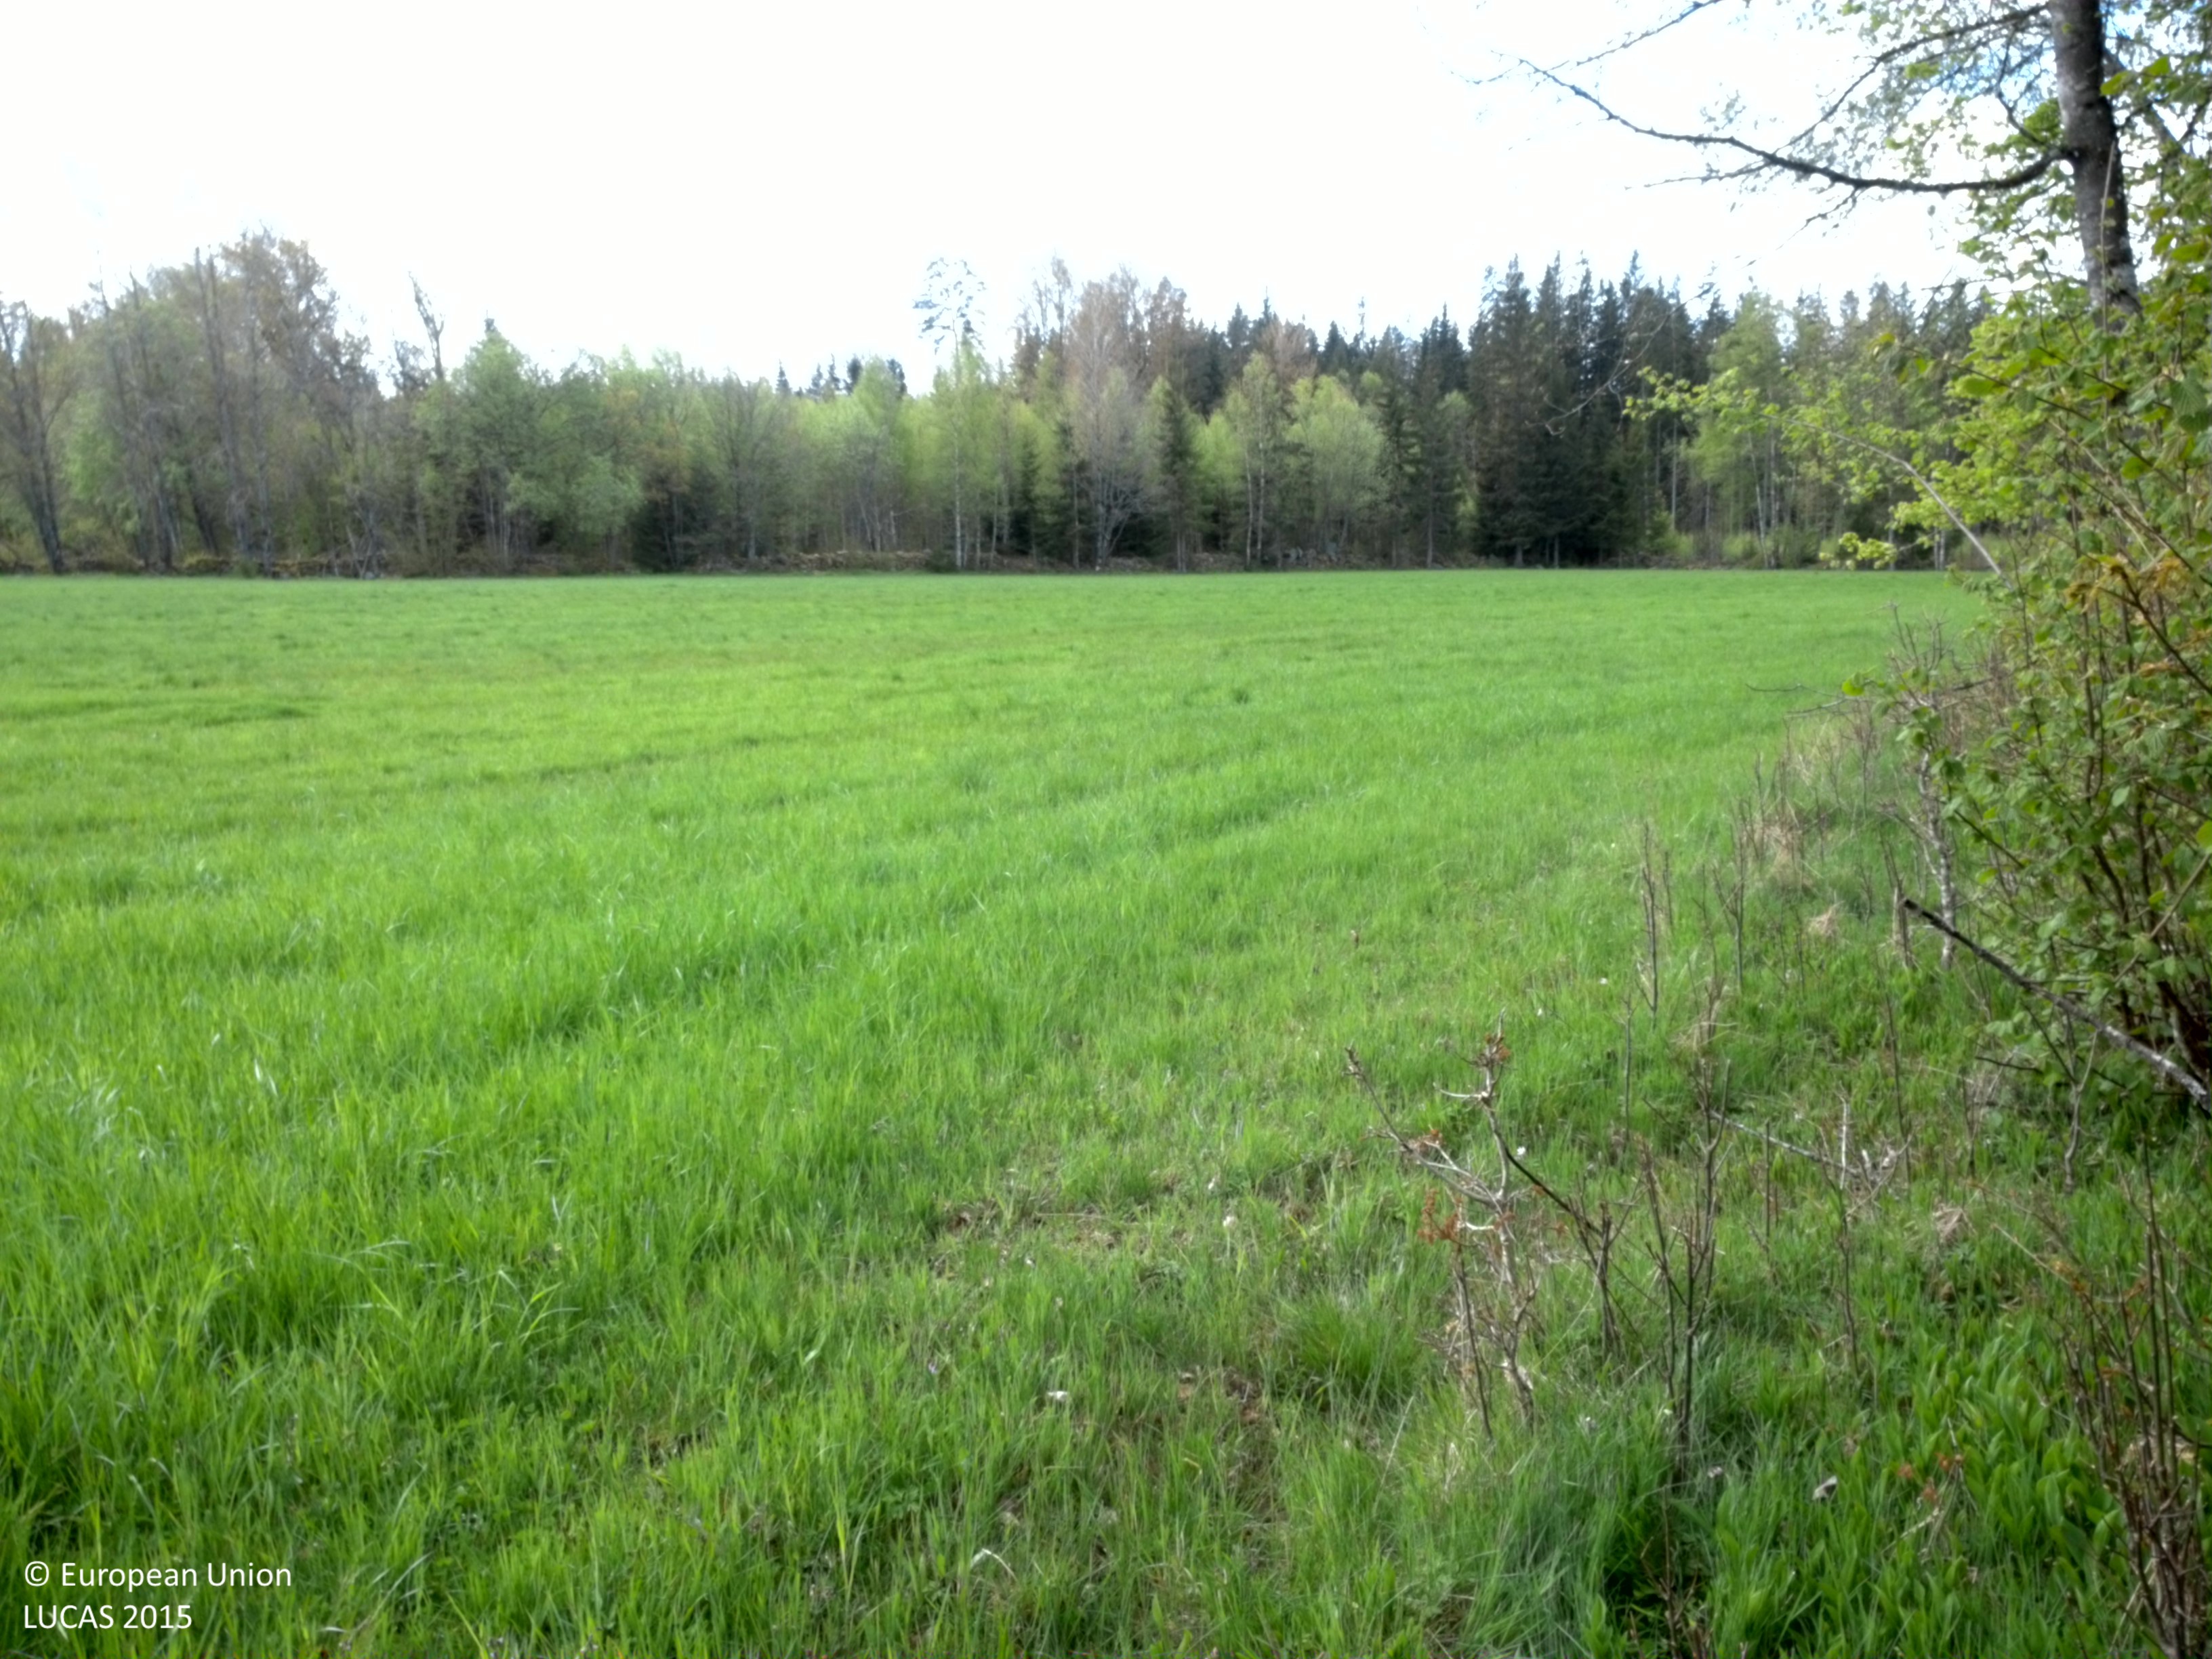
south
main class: Woodland
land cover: Broadleaved woodland
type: boreal forest
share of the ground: 50 - 75 %
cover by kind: broadleaved forest trees 50 %, herbaceous plants 30 %, coniferous forest trees 10 %, lichens and mosses 10 %
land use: Forestry
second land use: Amenities, museums, leisure
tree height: > 5 m
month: May
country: SE
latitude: 56.6537
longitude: 15.3322
